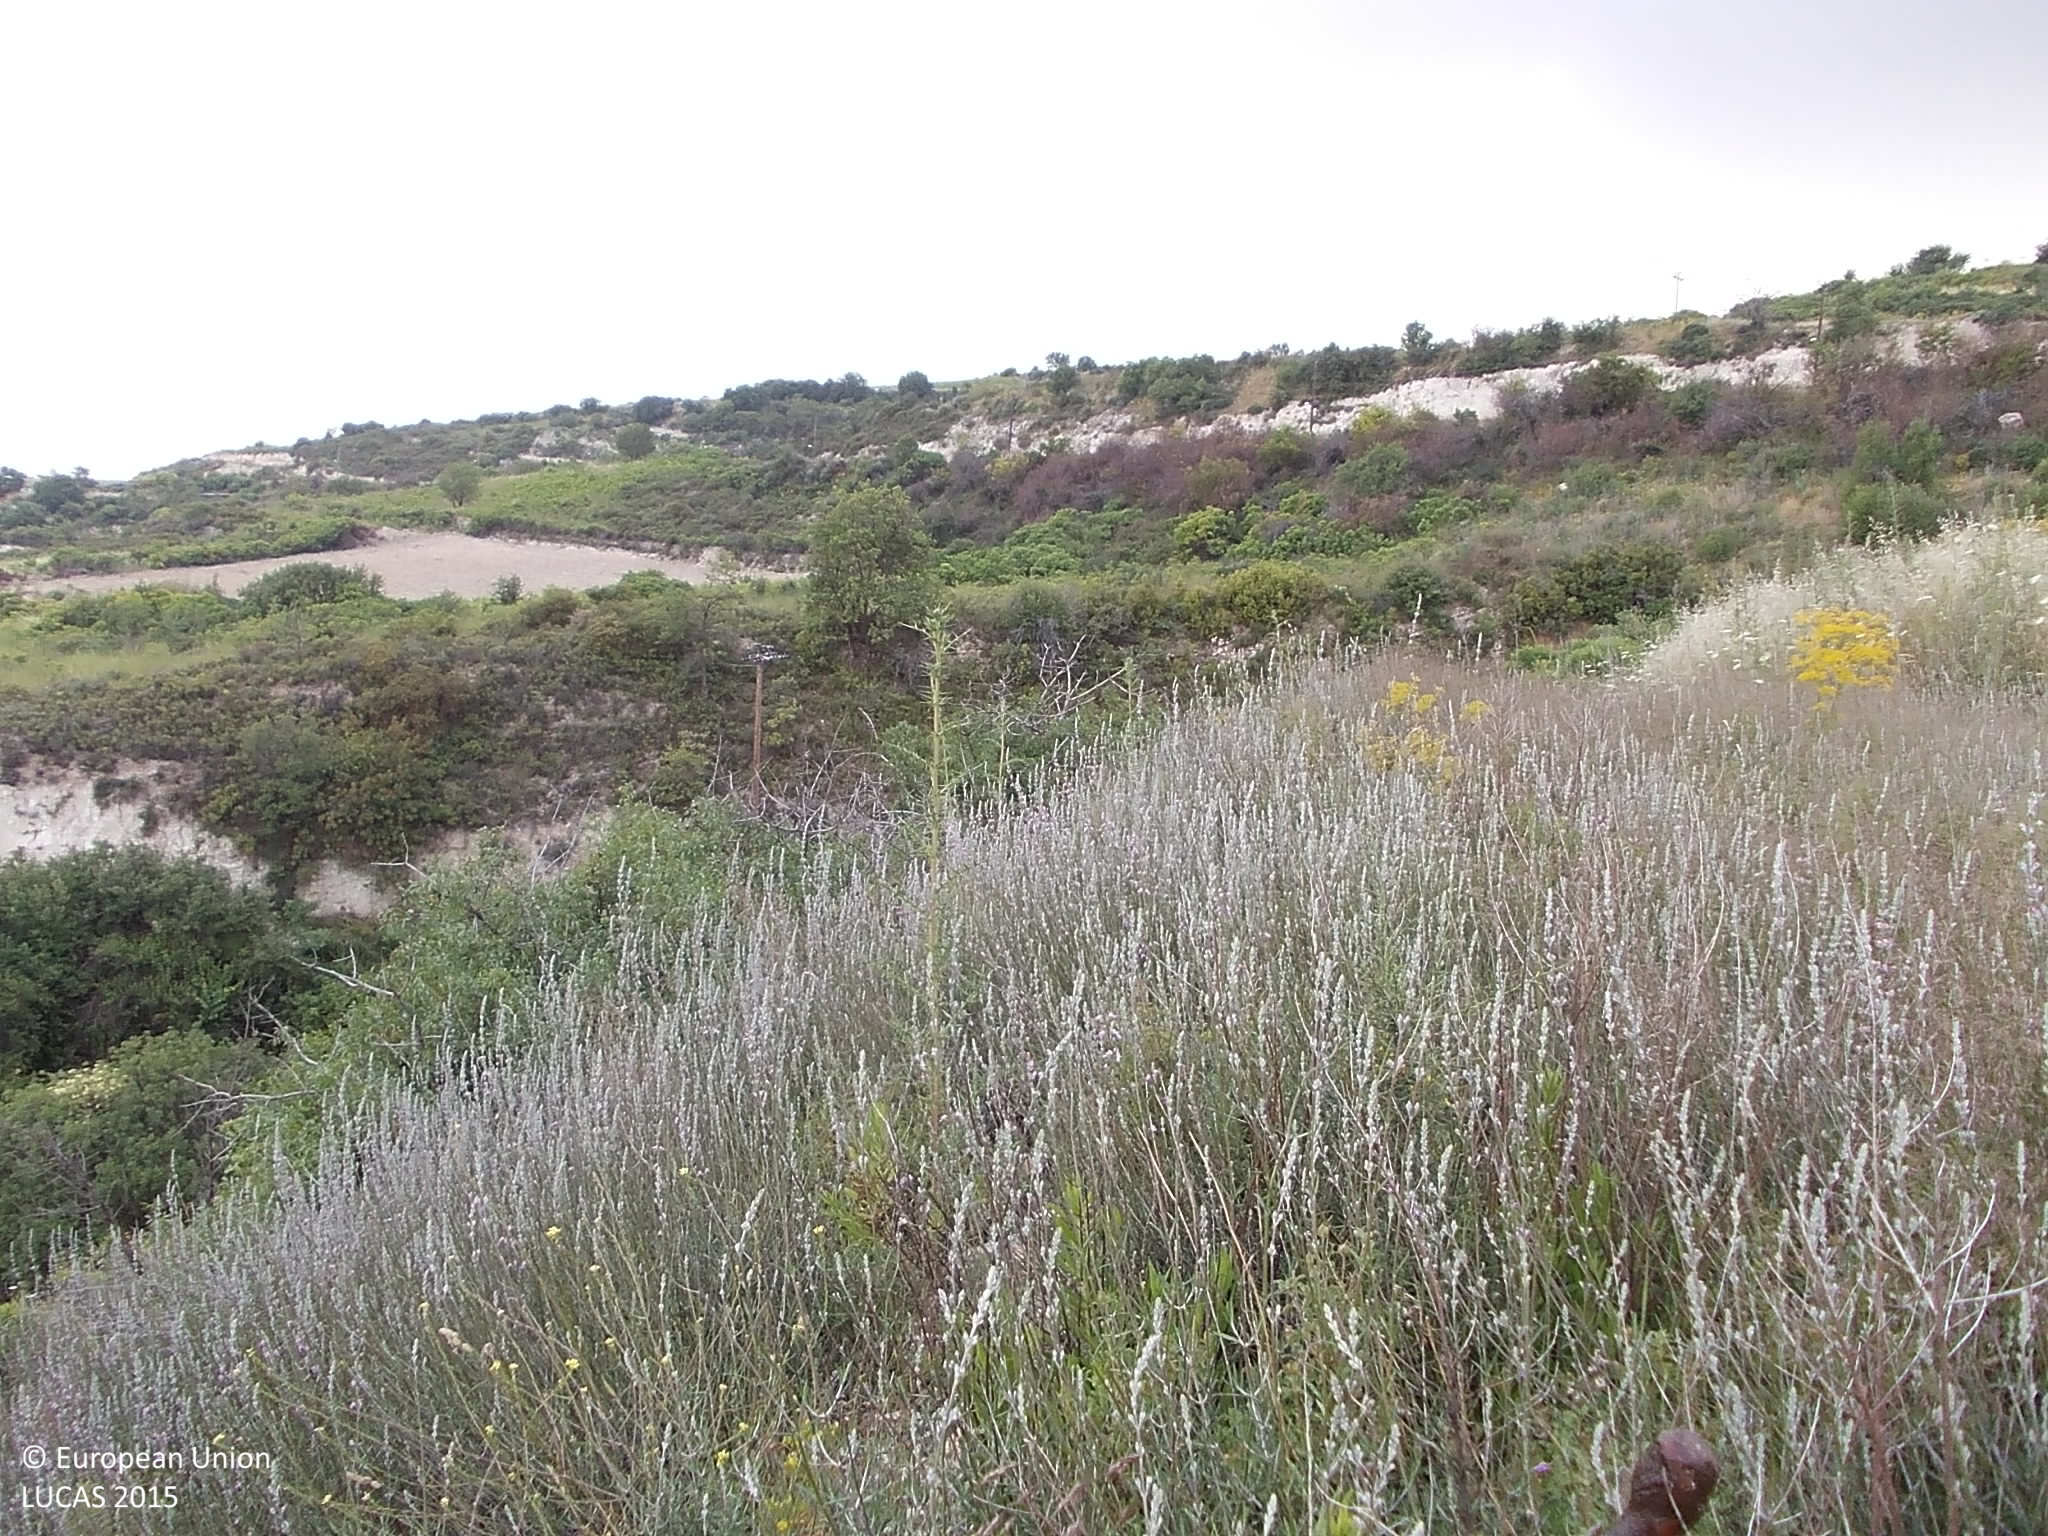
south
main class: Shrubland
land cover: Shrubland without tree cover
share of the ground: 10 - 25 %
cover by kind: herbaceous plants 75 %, shrubs 25 %
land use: Semi-natural and natural areas not in use
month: May
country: CY
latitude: 34.8425
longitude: 32.8094
